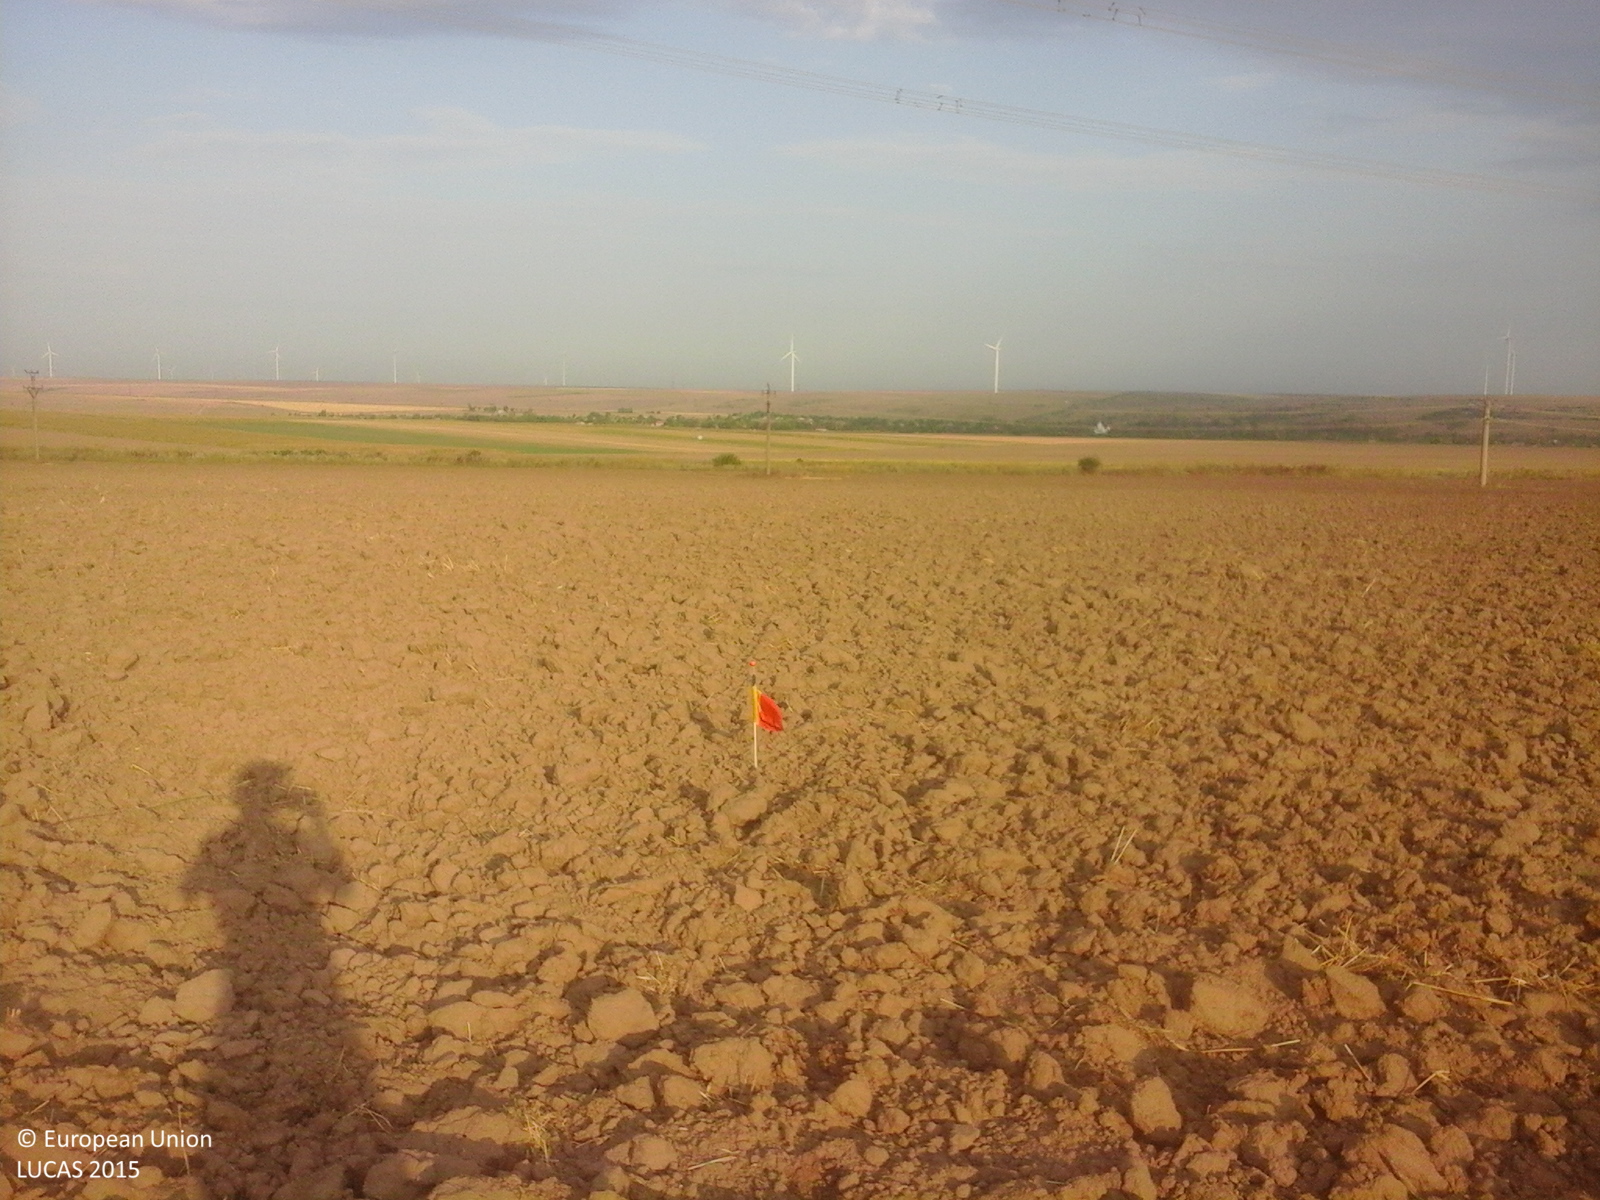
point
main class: Cropland
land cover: Common wheat
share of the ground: < 10 %
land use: Agriculture (excluding fallow land and kitchen gardens)
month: August
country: RO
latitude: 44.4111
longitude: 28.1572
